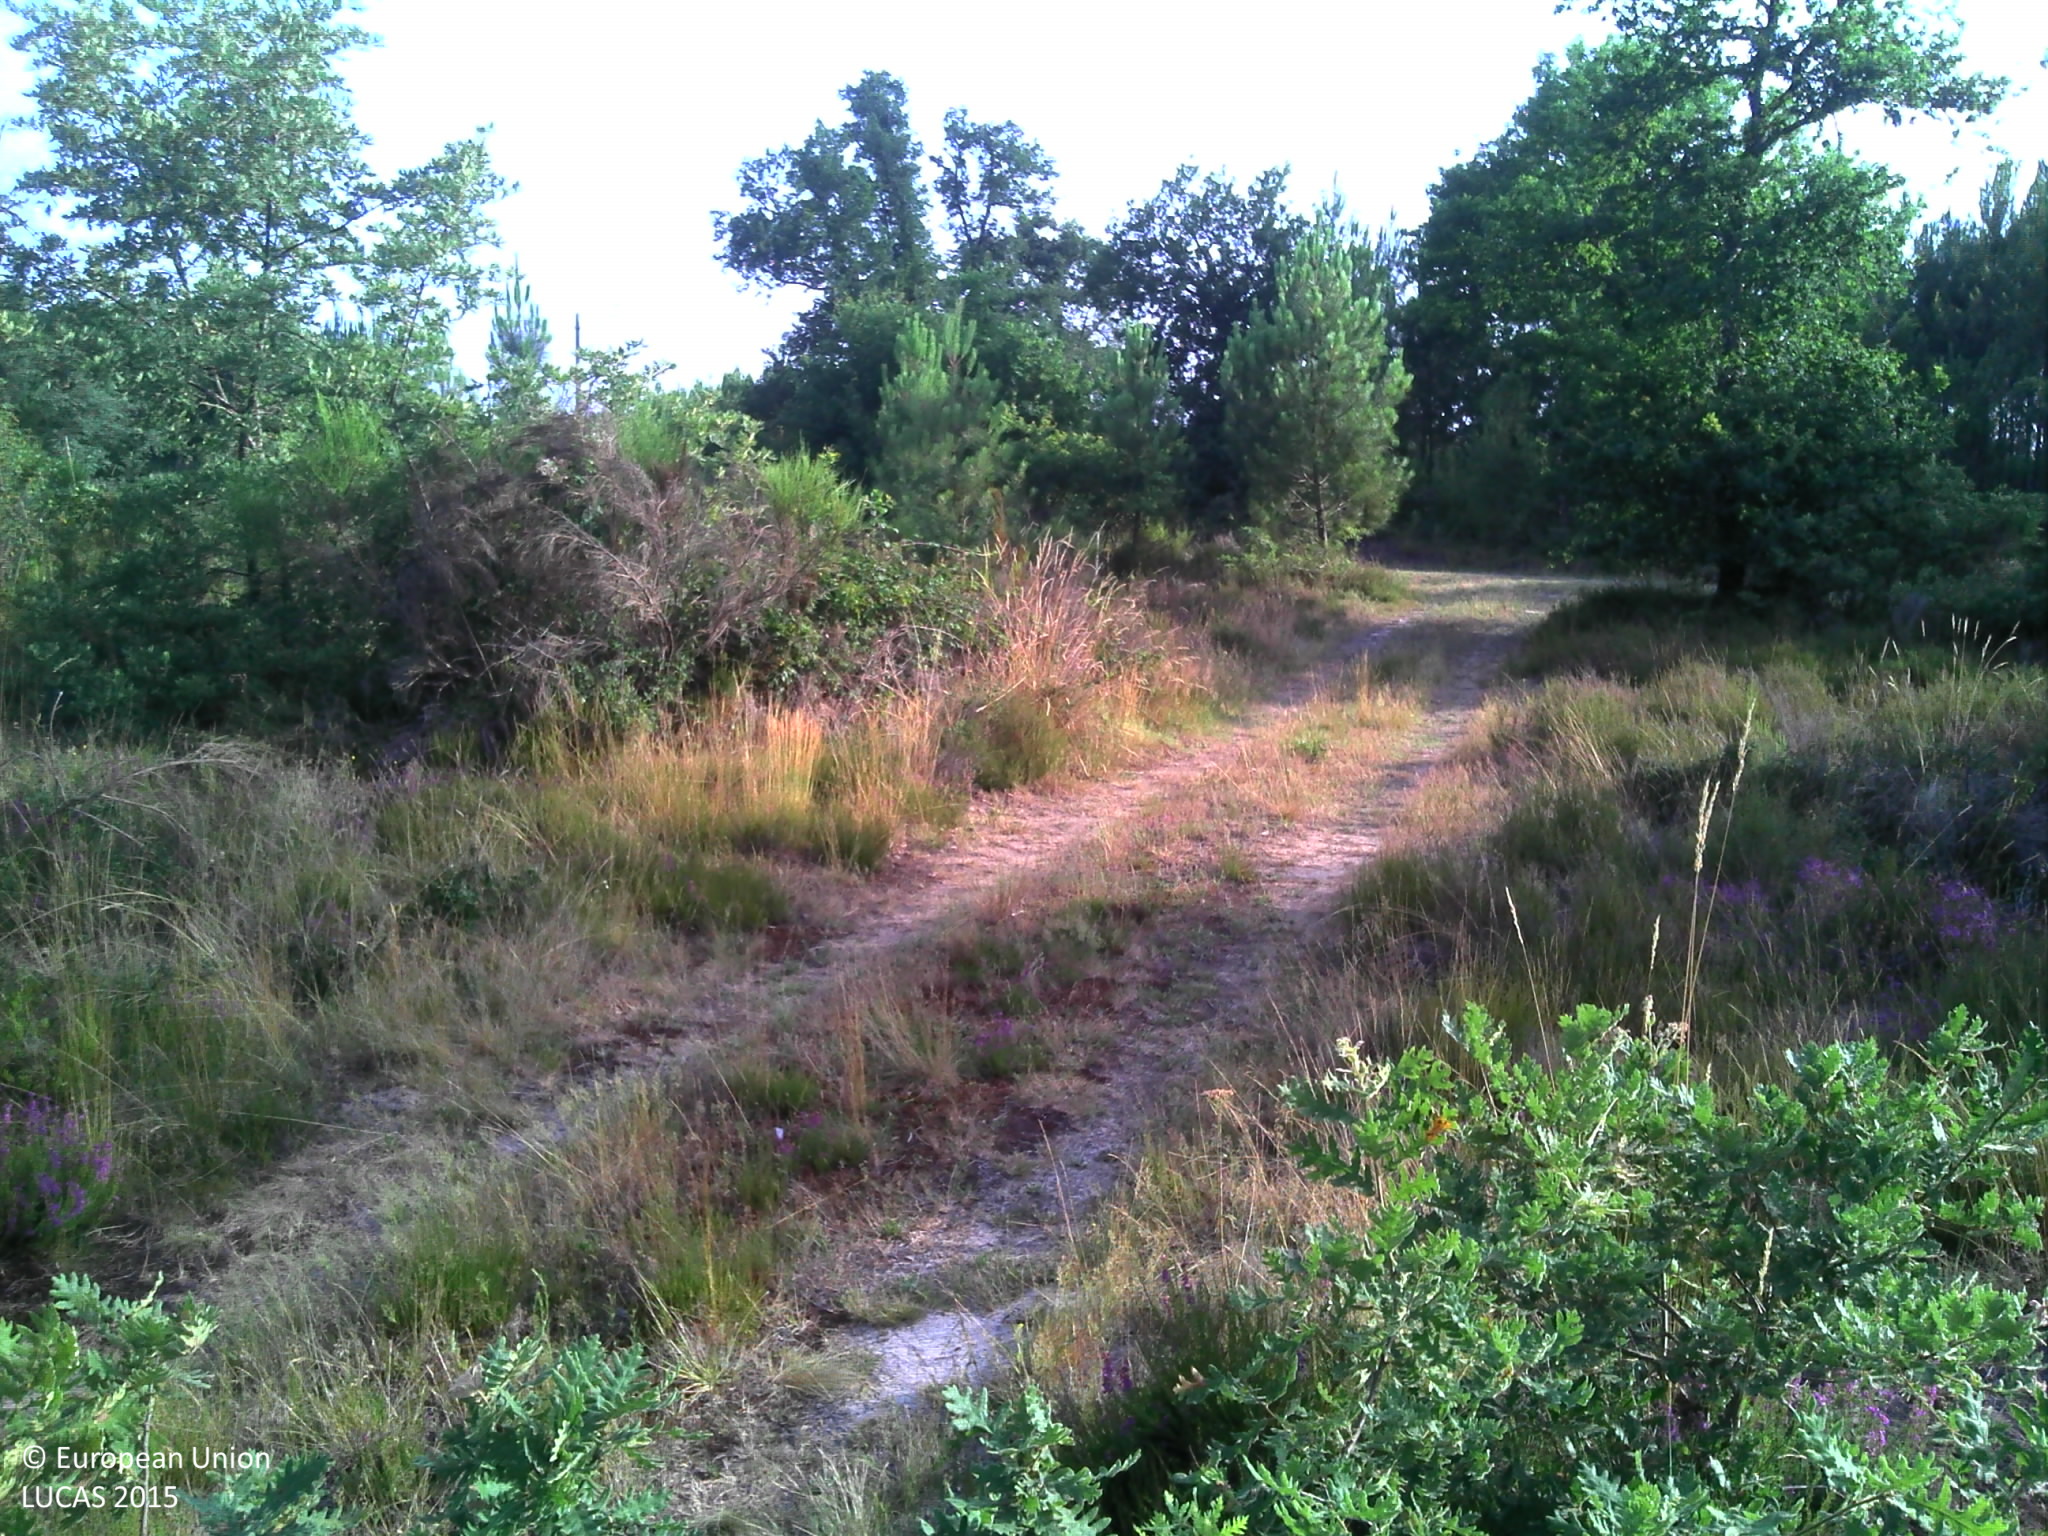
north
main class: Woodland
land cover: Pine dominated coniferous woodland
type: coniferous forest of the mediterranean region
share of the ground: 50 - 75 %
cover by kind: coniferous forest trees 70 %, herbaceous plants 20 %, broadleaved forest trees 10 %
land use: Forestry
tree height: < 5 m
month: July
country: FR
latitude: 44.0644
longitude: -0.5629
